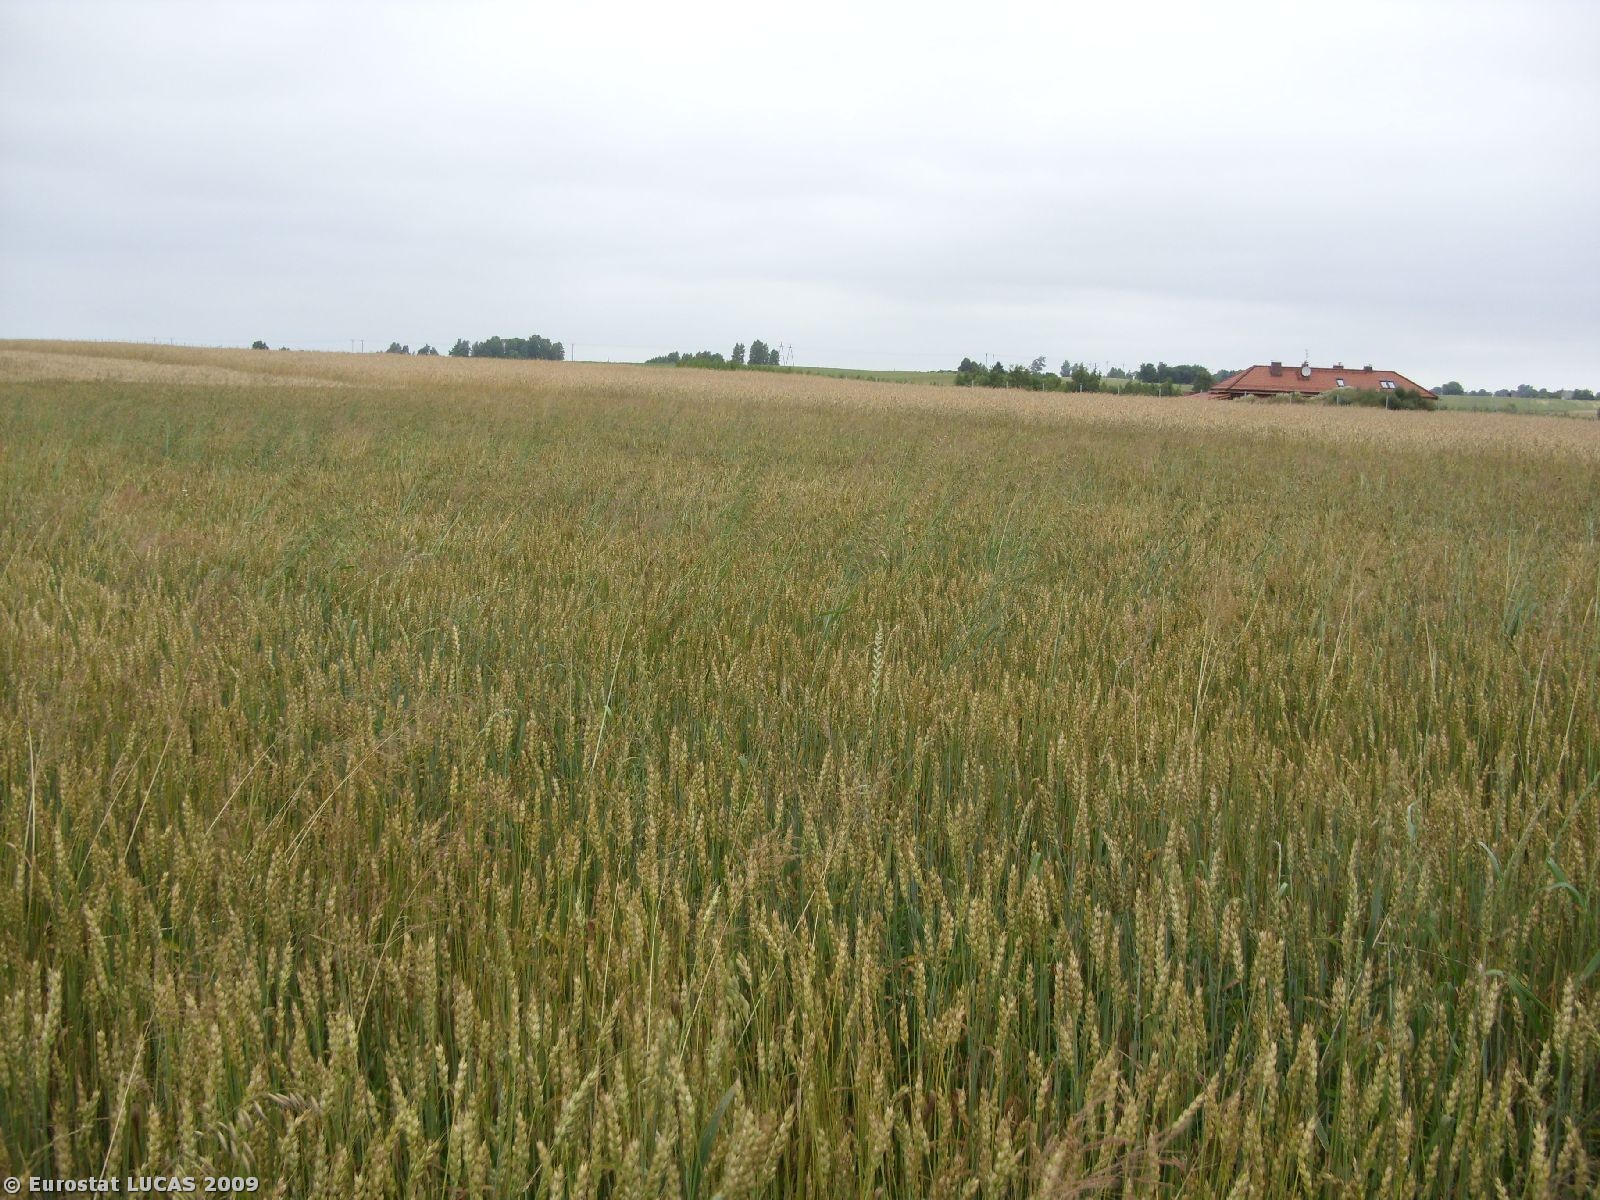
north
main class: Cropland
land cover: Common wheat
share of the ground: > 75 %
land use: Agriculture (excluding fallow land and kitchen gardens)
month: July
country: PL
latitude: 54.0662
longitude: 15.5802
